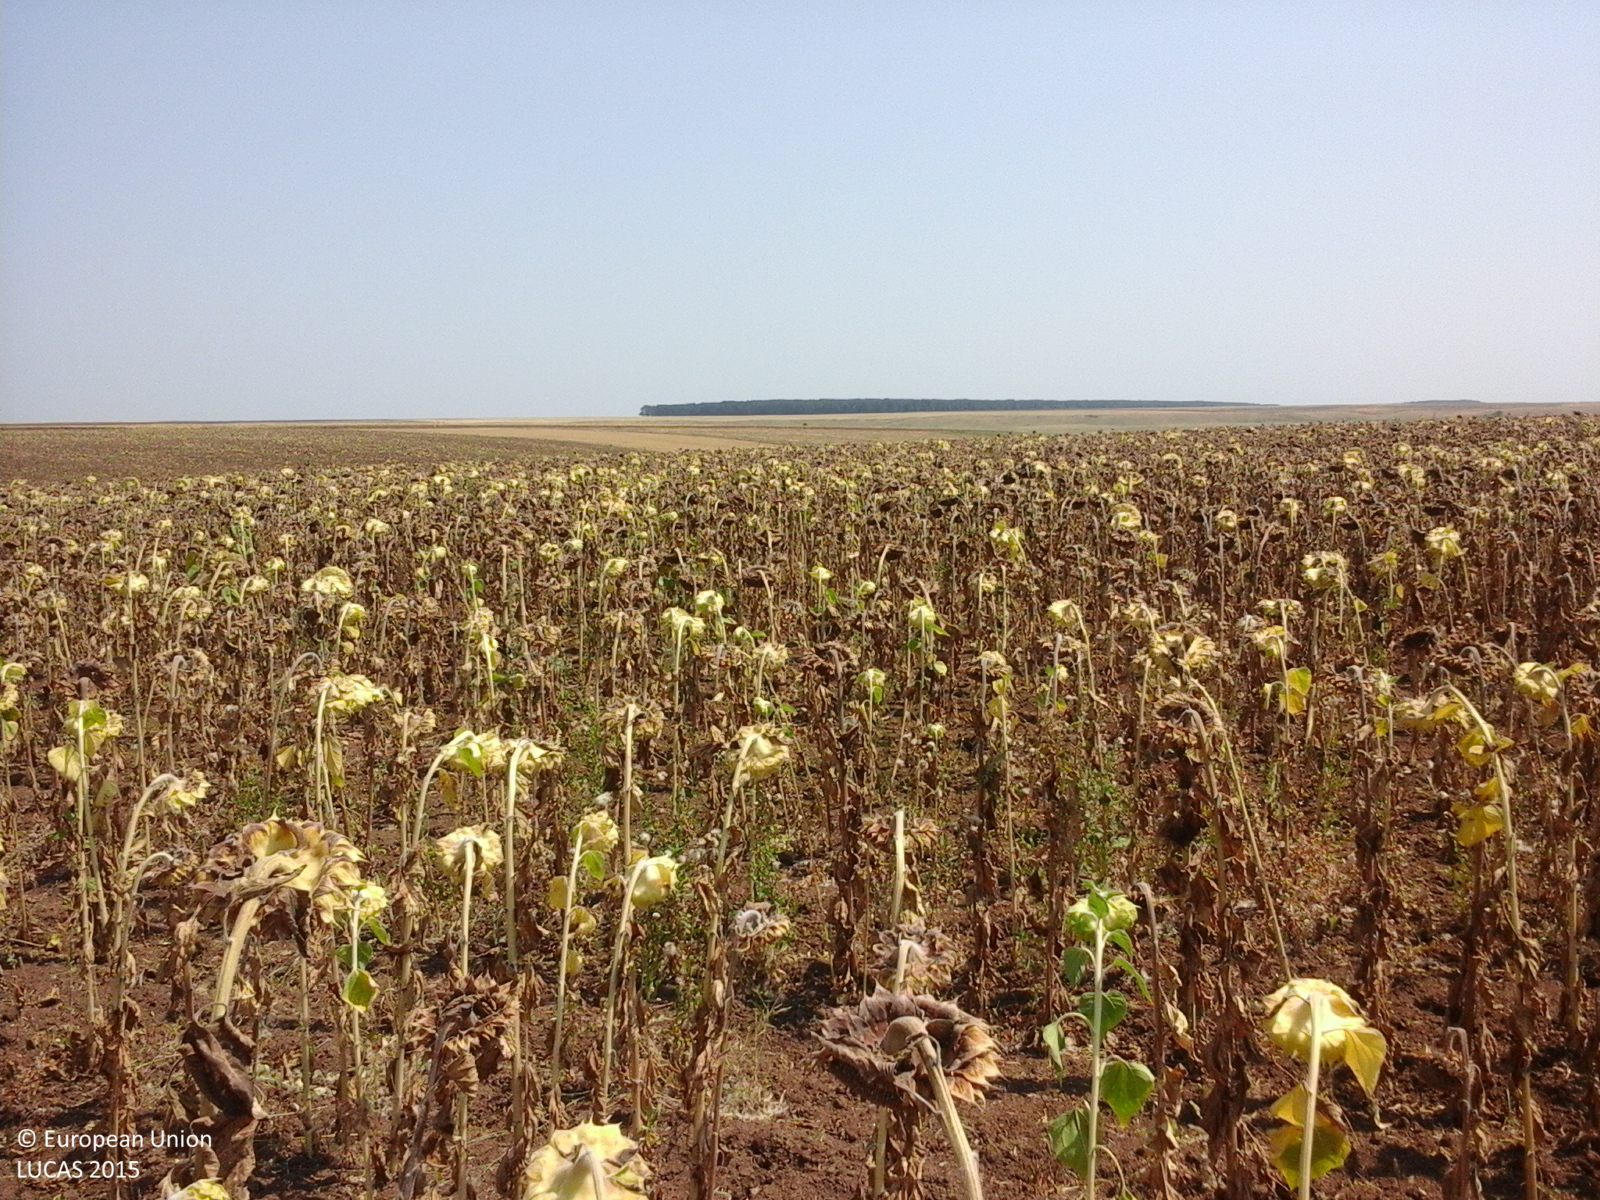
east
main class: Cropland
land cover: Sunflower
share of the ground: > 75 %
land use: Agriculture (excluding fallow land and kitchen gardens)
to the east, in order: Sunflower; Common wheat
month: August
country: RO
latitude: 44.2377
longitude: 23.3078
